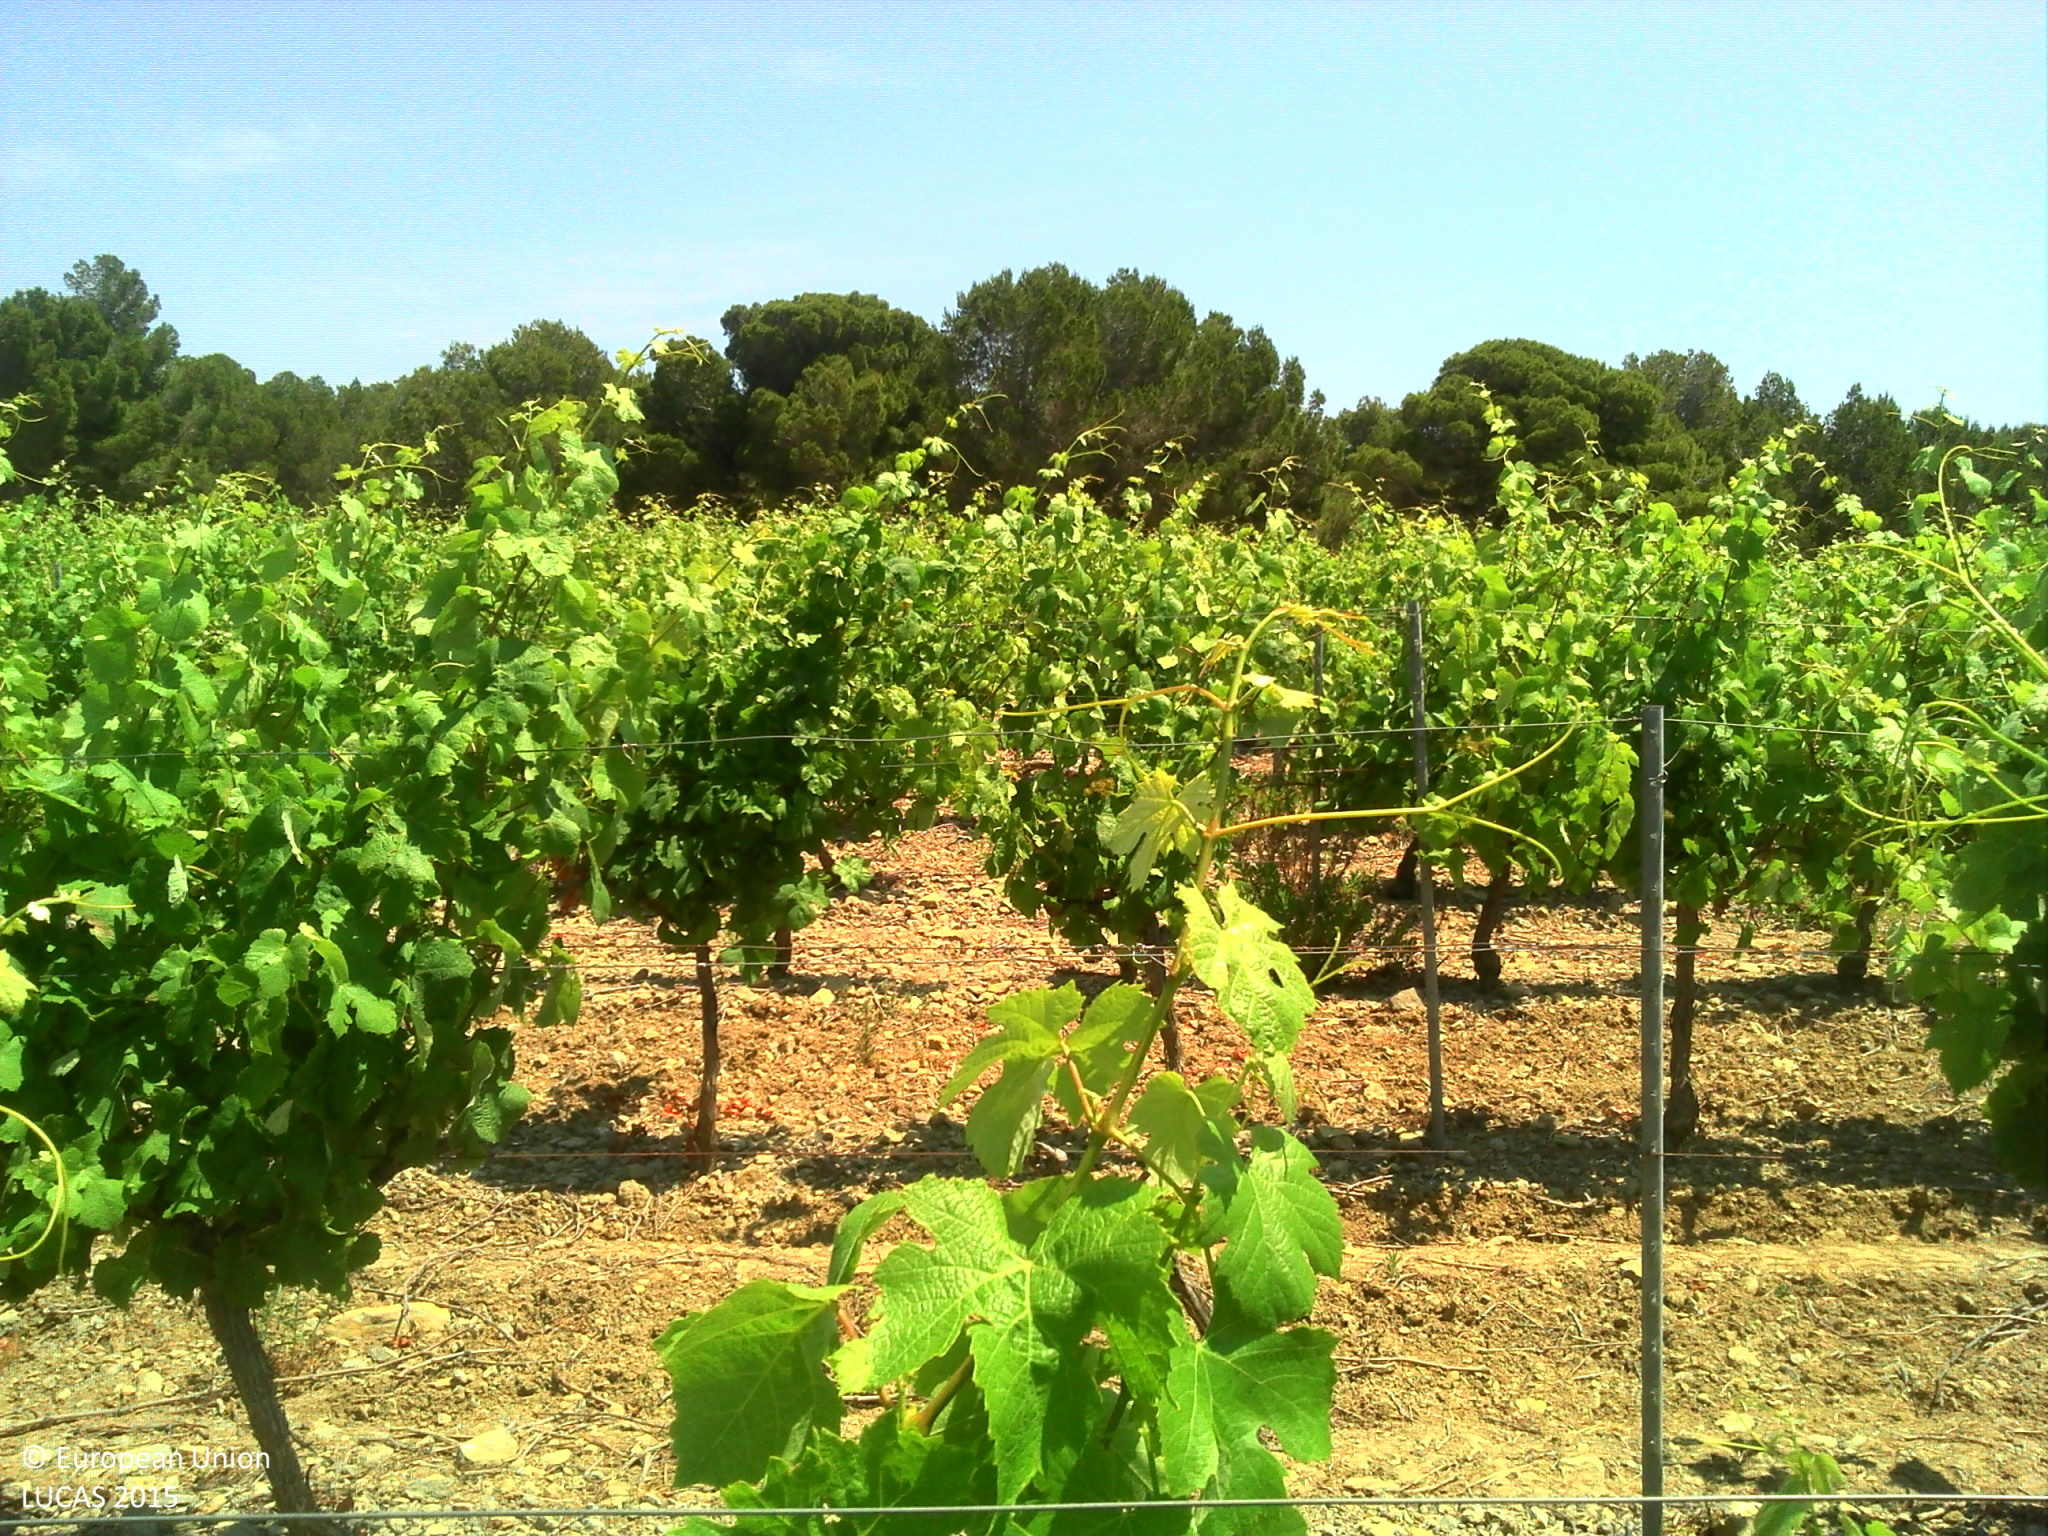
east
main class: Cropland
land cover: Vineyards
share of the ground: 50 - 75 %
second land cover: Other bare soil
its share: > 75 %
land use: Agriculture (excluding fallow land and kitchen gardens)
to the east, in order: Vineyards; Other bare soil; Grassland without tree/shrub cover; Tracks; Pine dominated coniferous woodland; Tracks; Pine dominated coniferous woodland; Paved roads, cycling and walking lanes; Pine dominated coniferous woodland
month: June
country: FR
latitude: 43.1260
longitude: 3.1145
